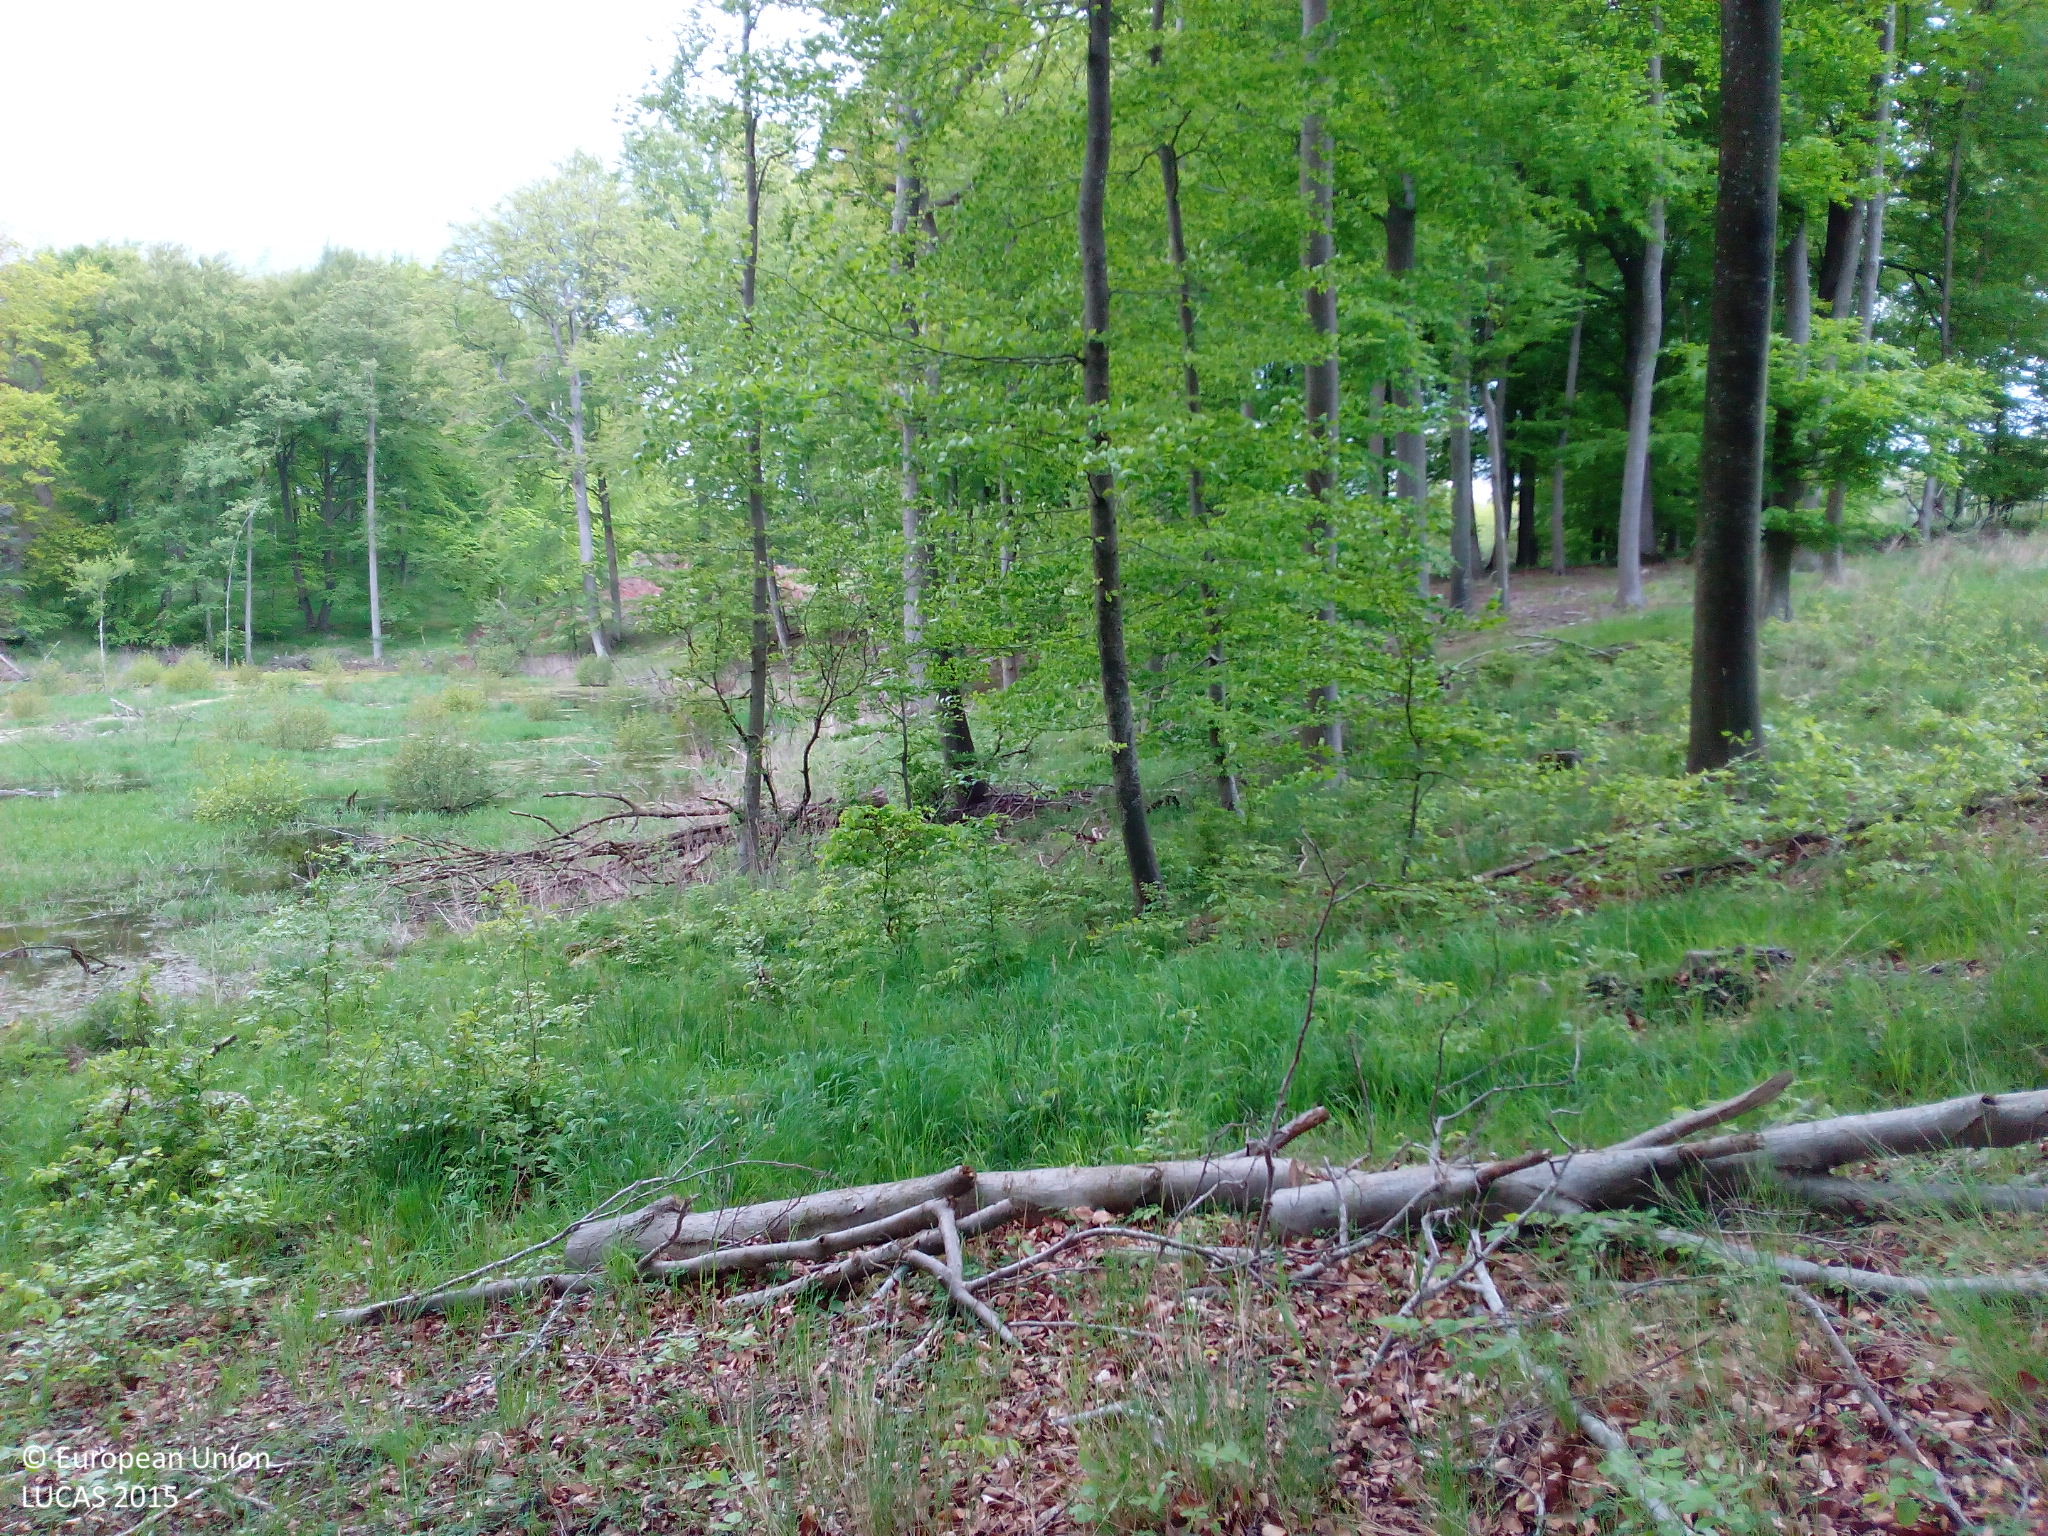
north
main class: Woodland
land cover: Broadleaved woodland
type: beech forest
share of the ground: > 75 %
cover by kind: broadleaved forest trees 95 %, herbaceous plants 5 %
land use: Forestry
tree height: > 5 m
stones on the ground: < 10 %
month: May
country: DK
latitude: 55.6340
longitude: 11.9204
